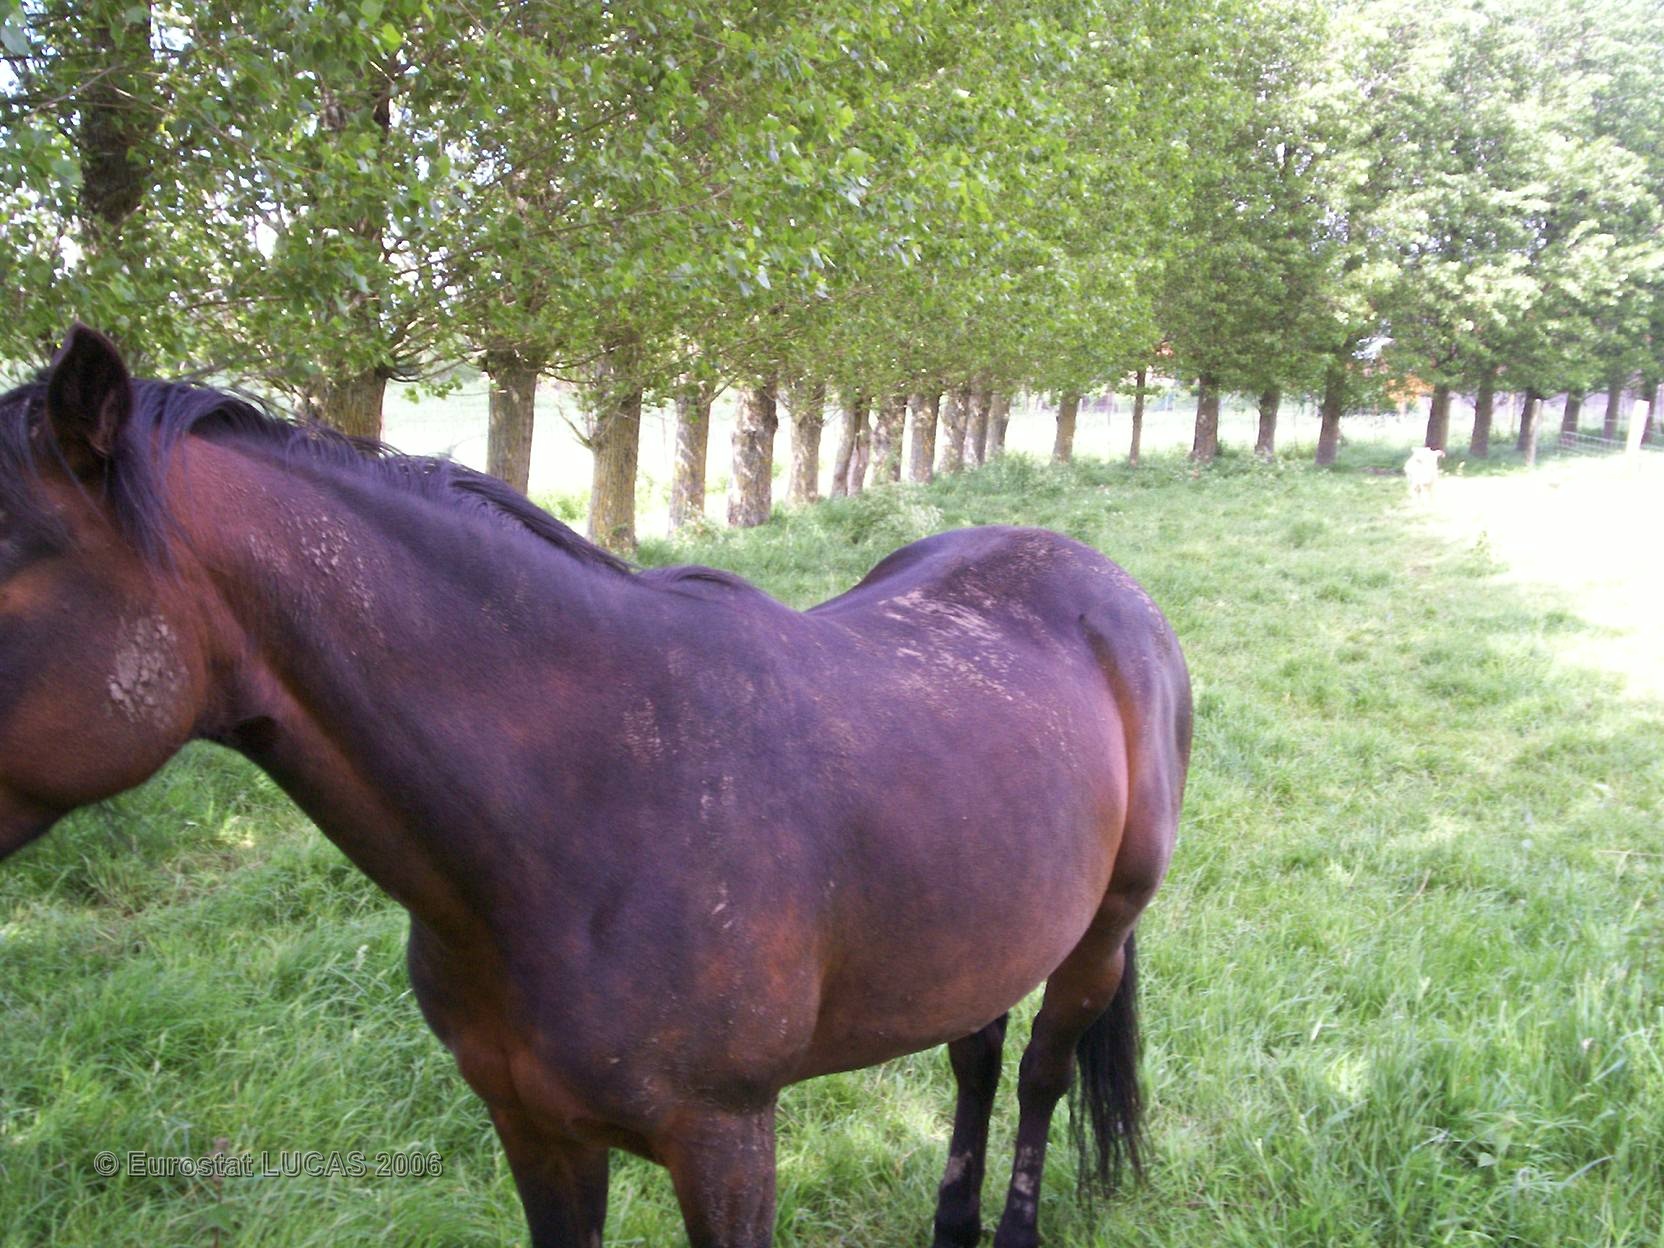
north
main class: Grassland
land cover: Grassland with sparse tree/shrub cover
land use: Agriculture (excluding fallow land and kitchen gardens)
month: May
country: FR
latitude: 50.9117
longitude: 2.4918
